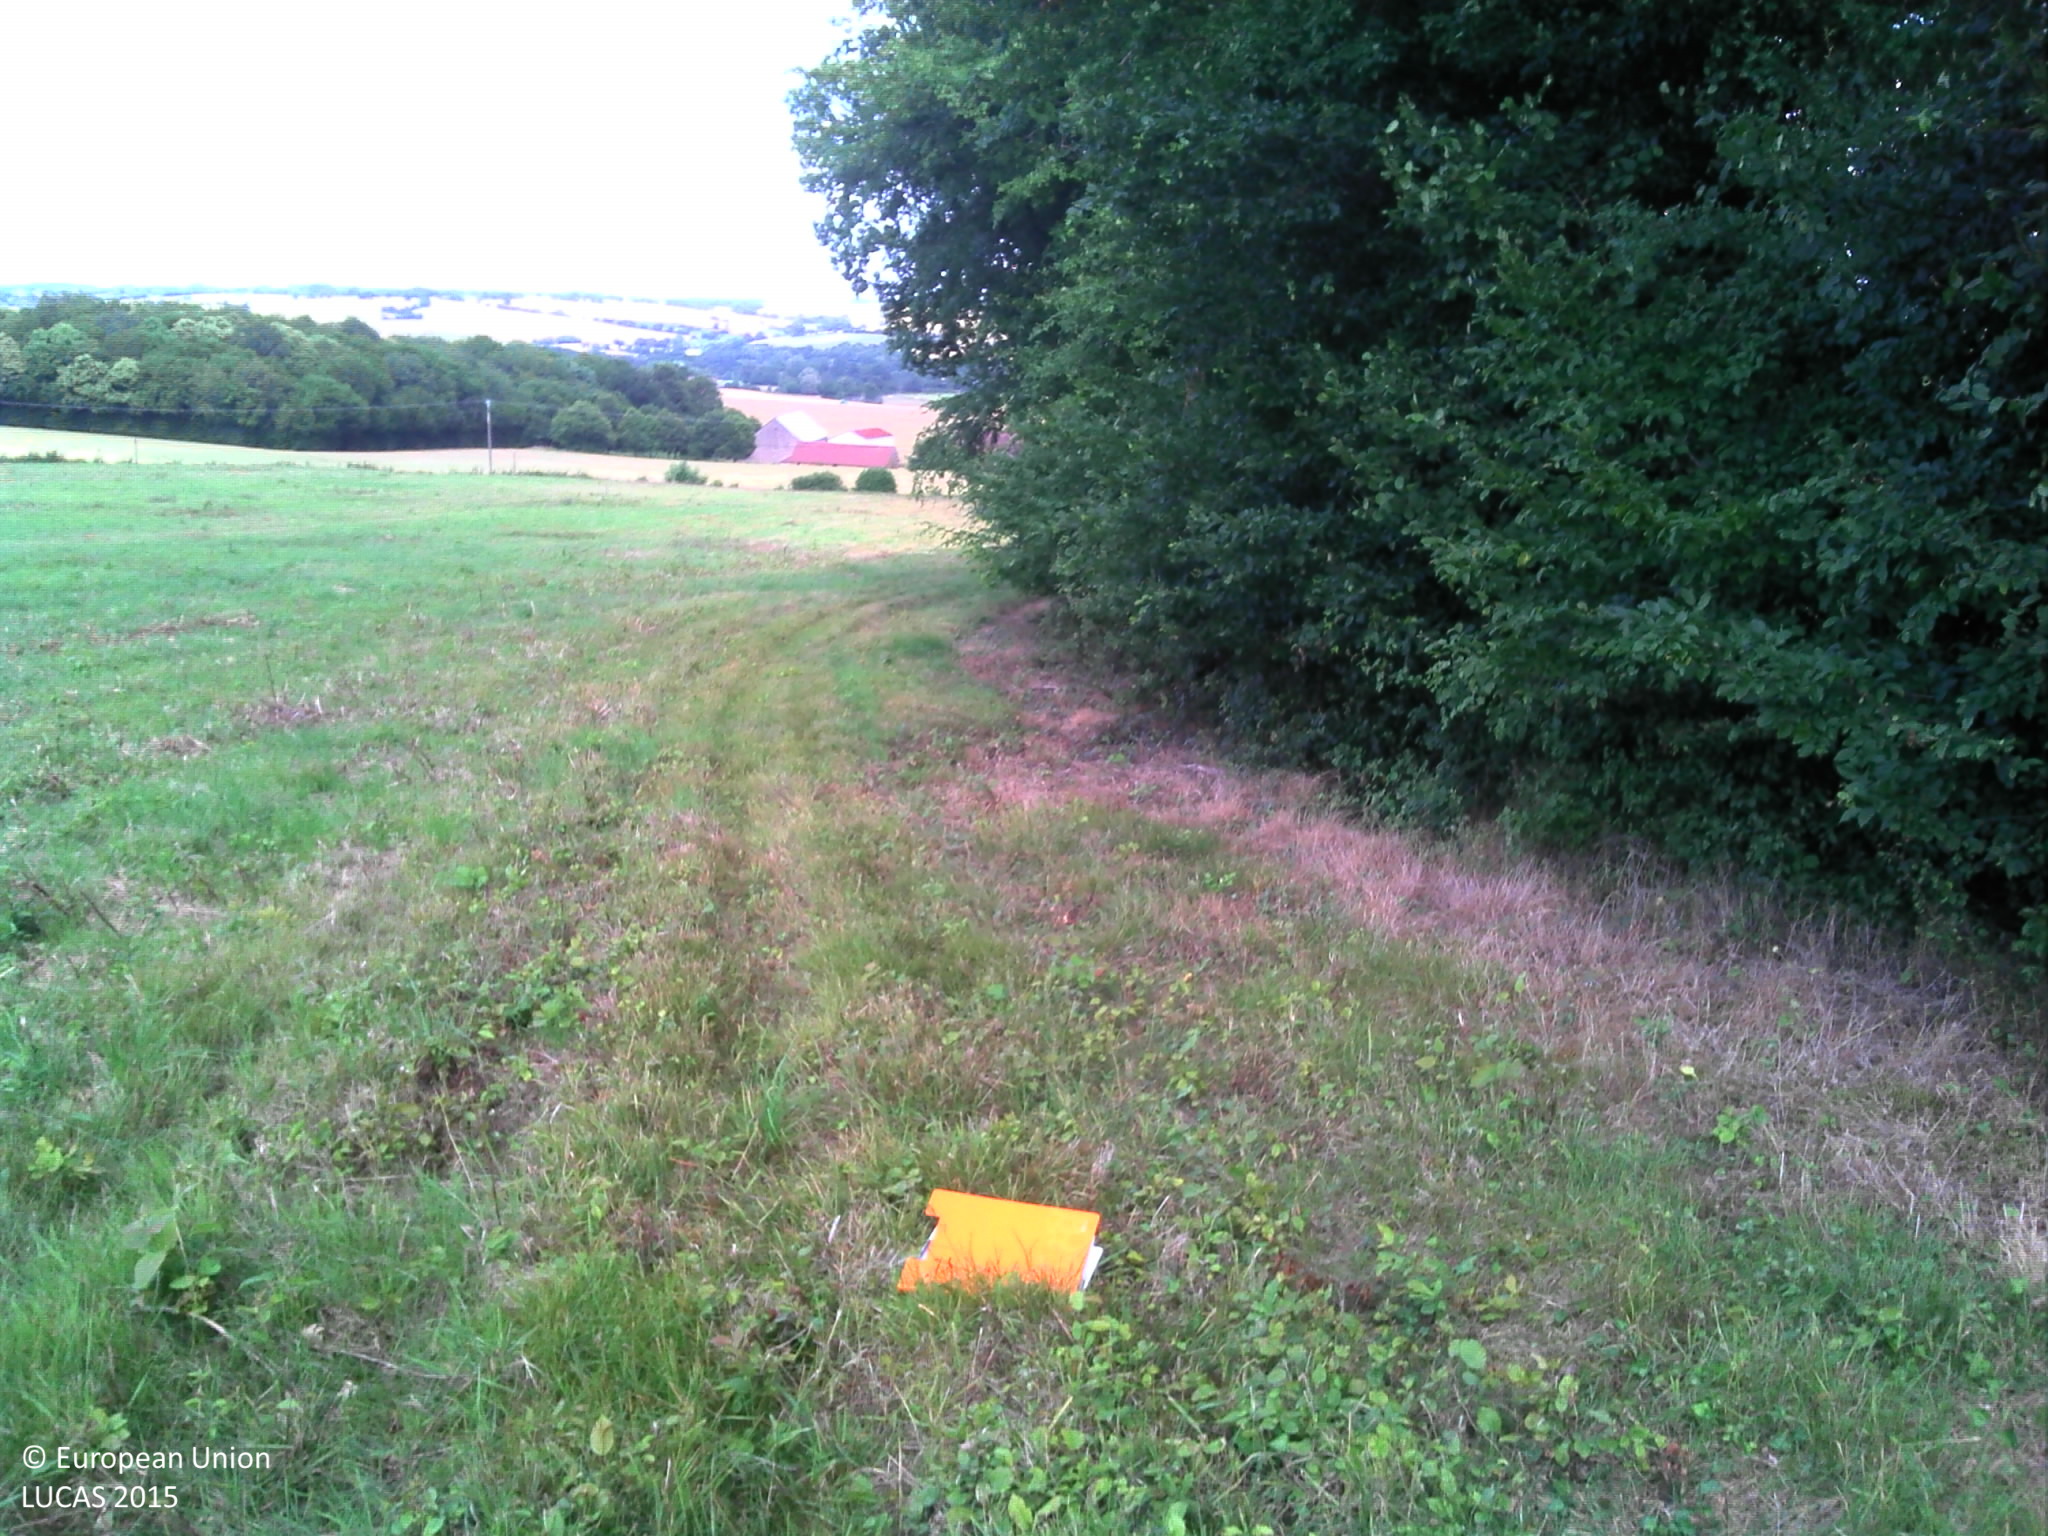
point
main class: Grassland
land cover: Grassland without tree/shrub cover
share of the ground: > 75 %
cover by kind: herbaceous plants 100 %
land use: Agriculture (excluding fallow land and kitchen gardens)
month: June
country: FR
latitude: 47.3113
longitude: 2.6783
